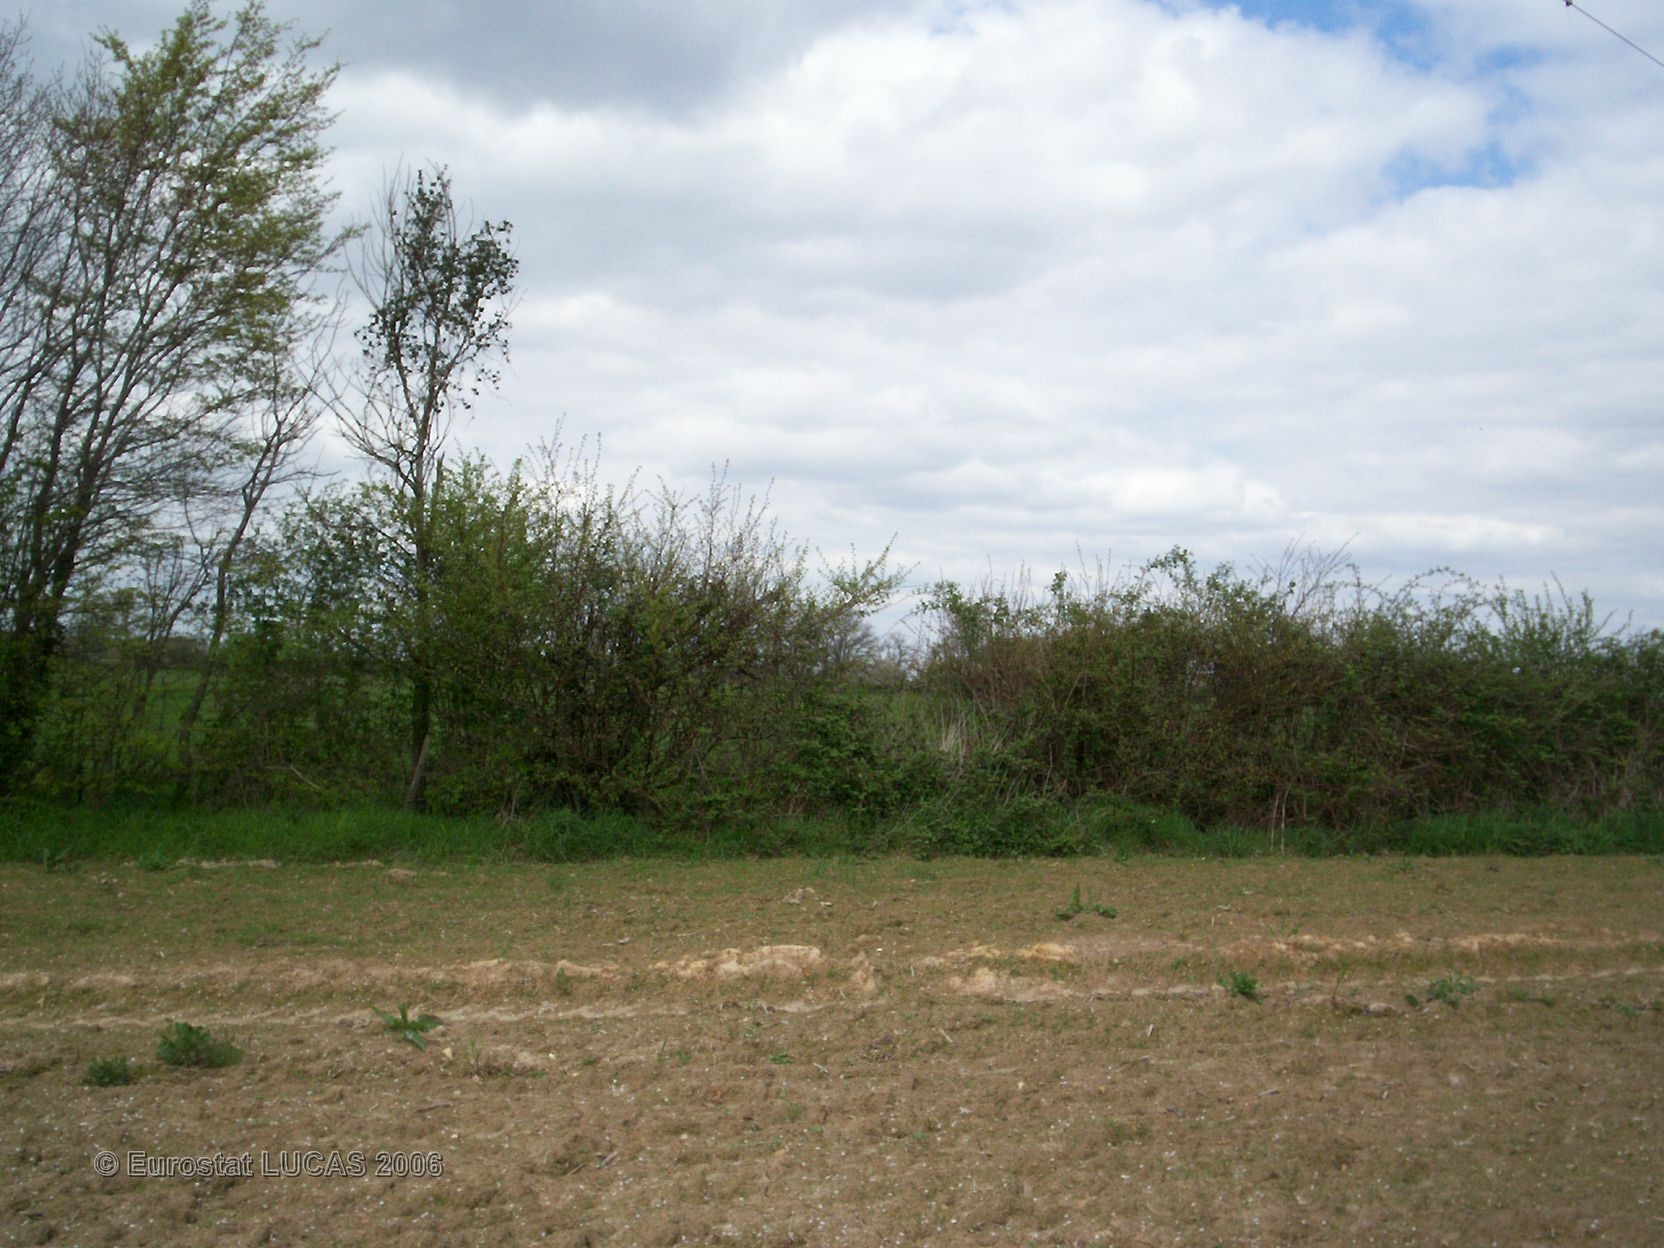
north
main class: Grassland
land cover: Grassland without tree/shrub cover
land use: Agriculture (excluding fallow land and kitchen gardens)
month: April
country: FR
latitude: 46.1849
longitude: 0.5396
